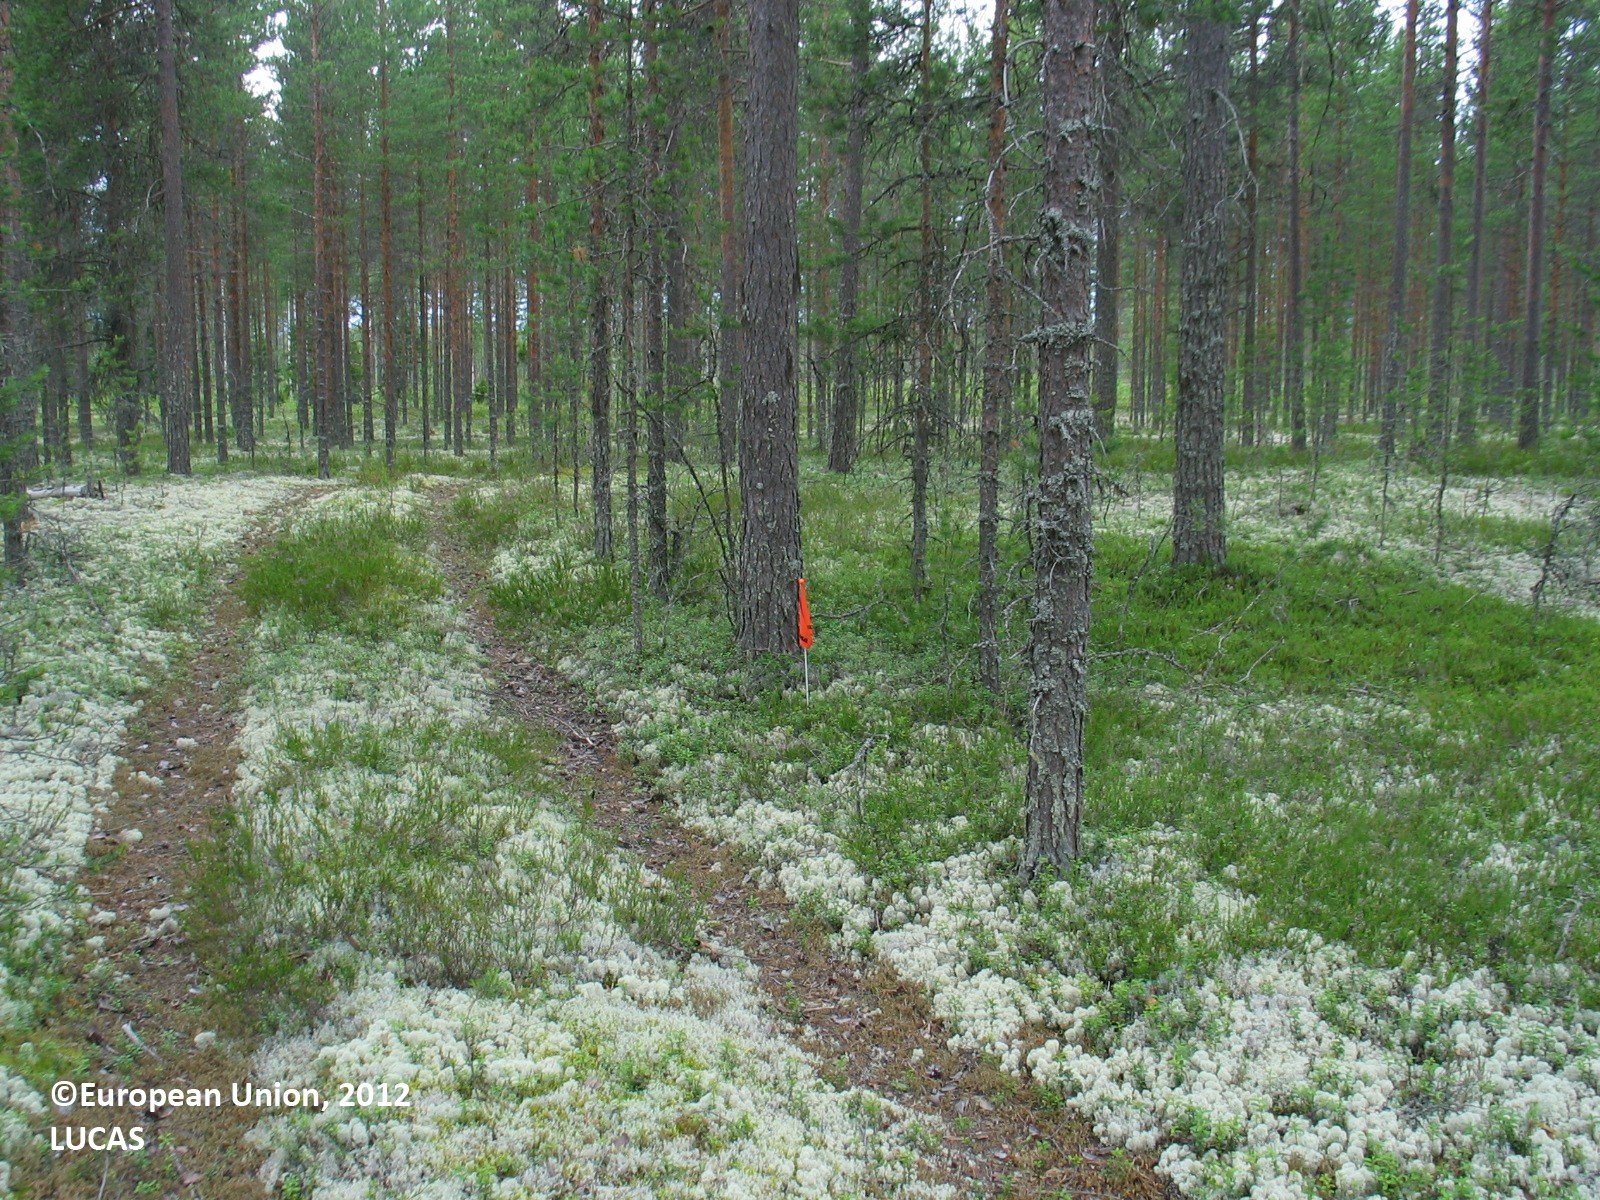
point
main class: Woodland
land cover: Pine dominated coniferous woodland
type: boreal forest
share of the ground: 50 - 75 %
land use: Forestry
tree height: > 5 m
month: July
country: FI
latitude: 64.6336
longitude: 26.3646
